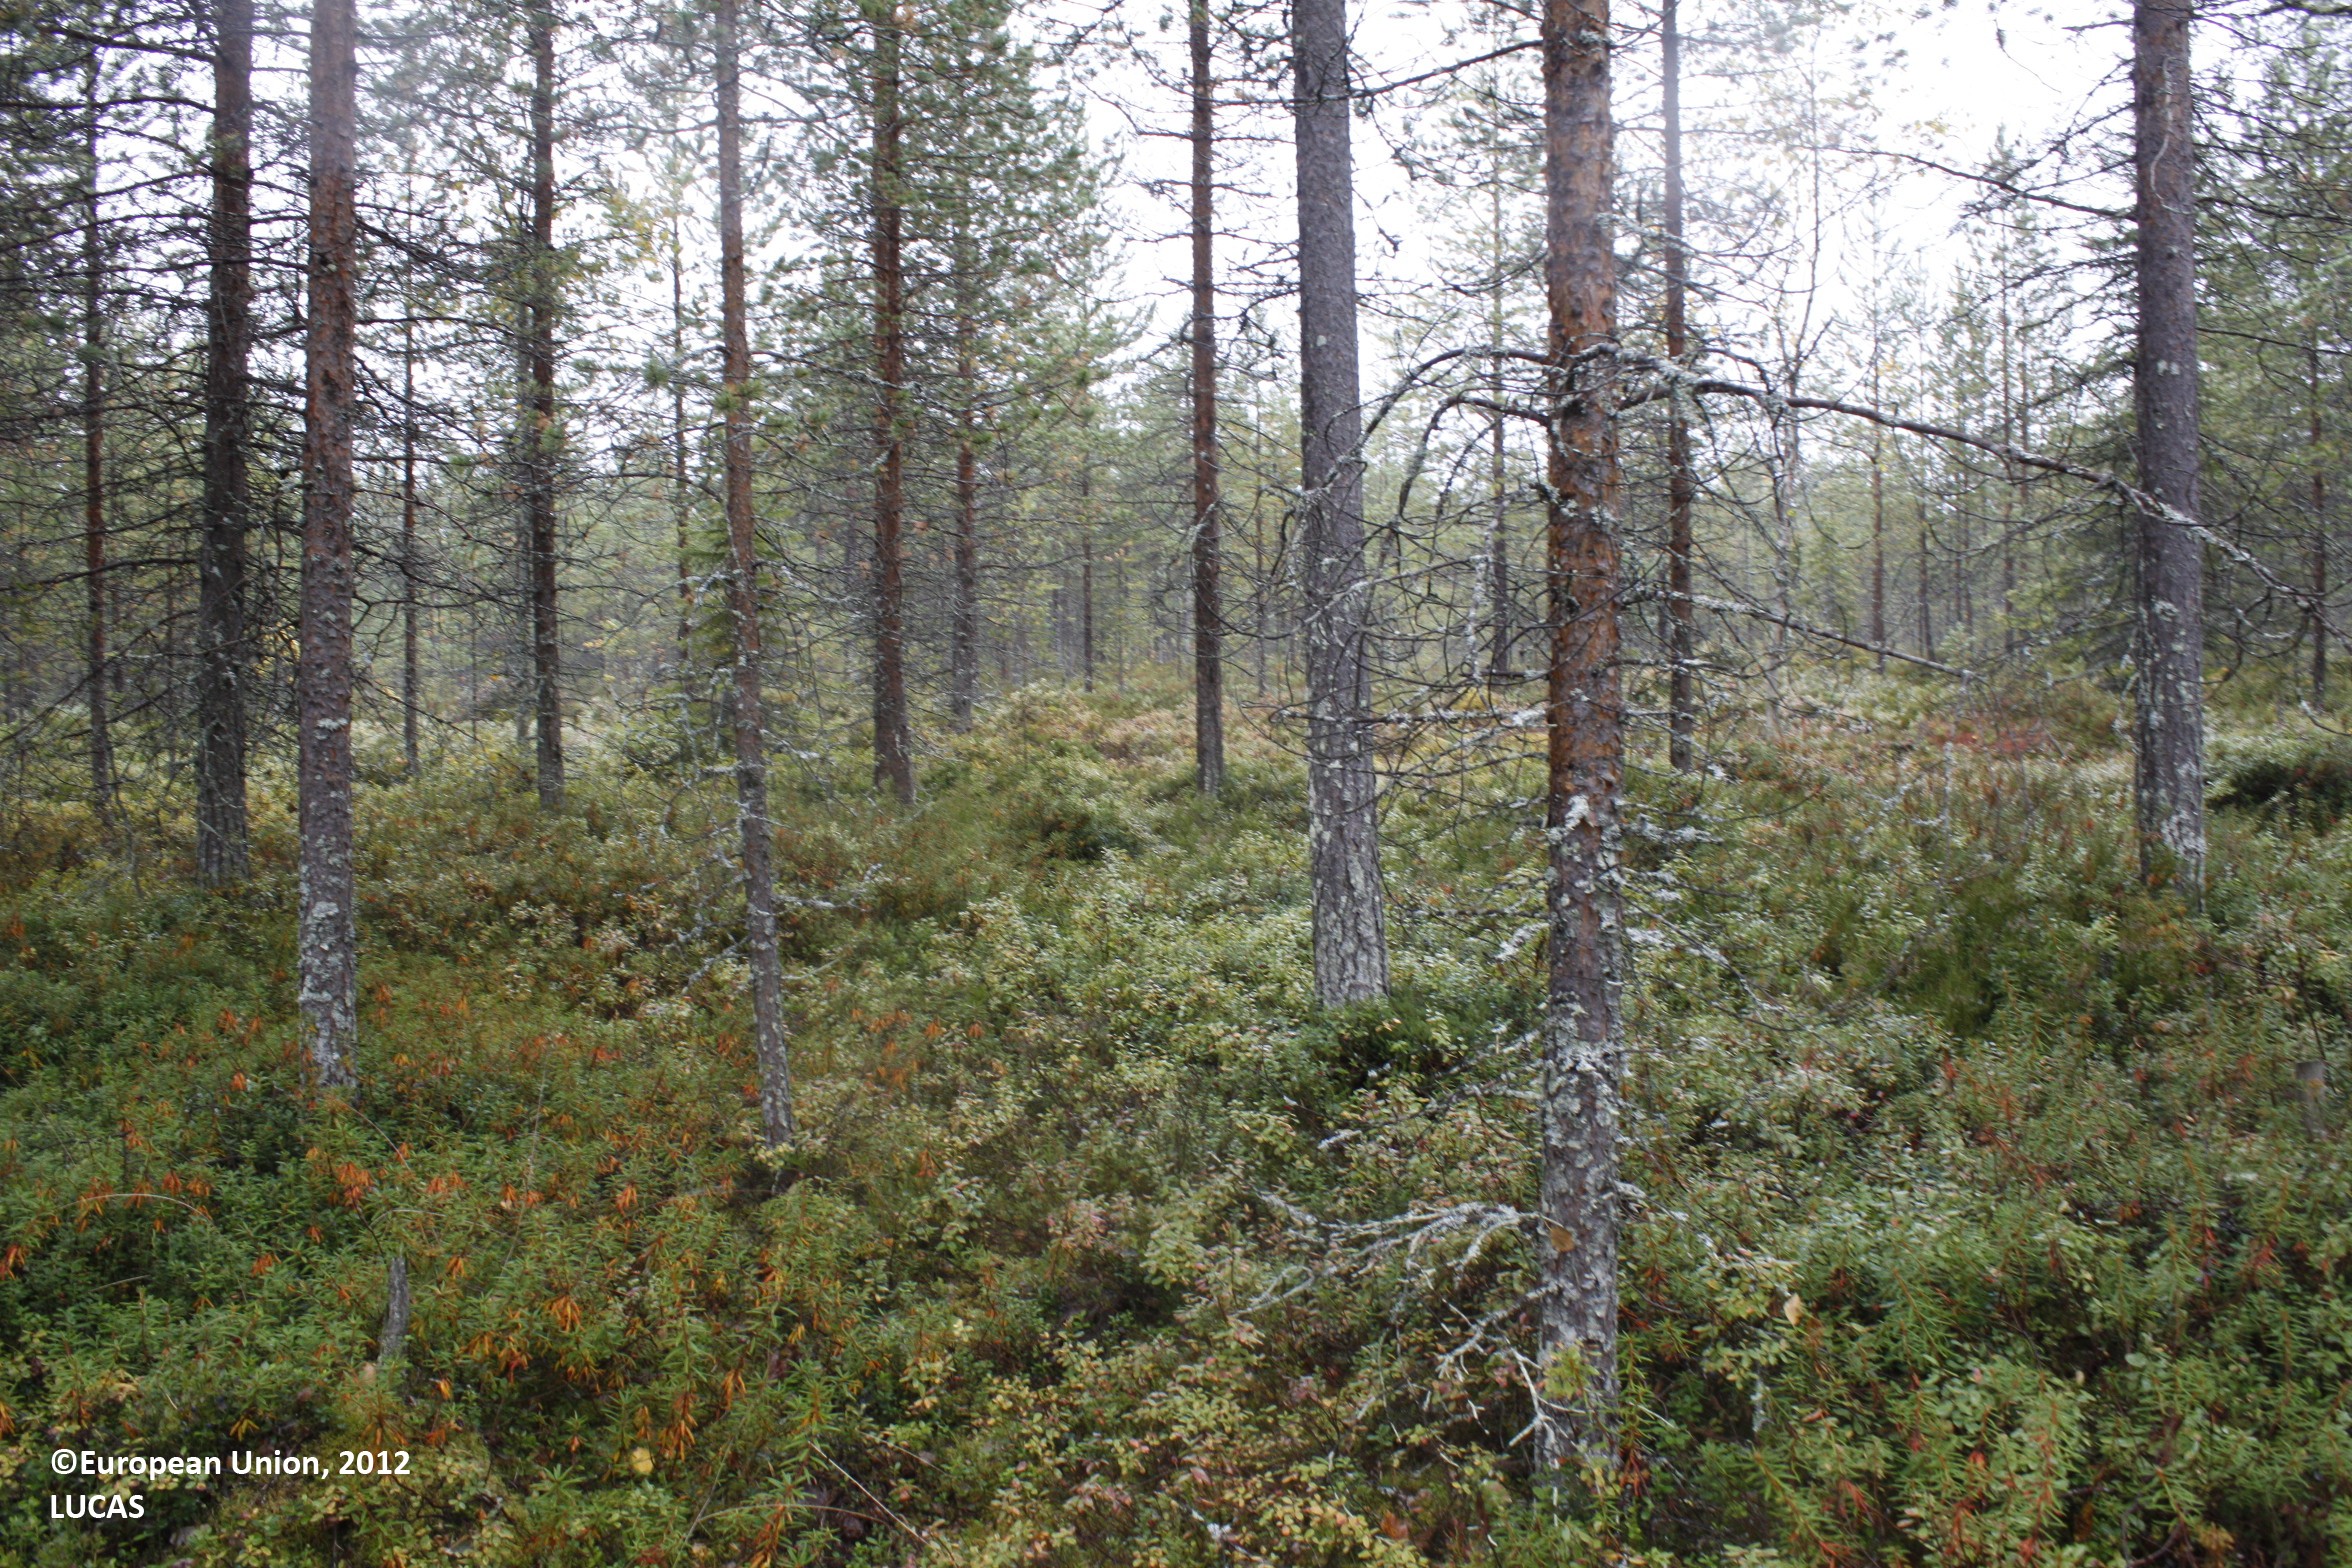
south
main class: Woodland
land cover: Pine dominated mixed woodland
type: mire and swamp forests
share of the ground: 25 - 50 %
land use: Forestry
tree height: > 5 m
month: September
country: FI
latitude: 65.3362
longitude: 26.9315
